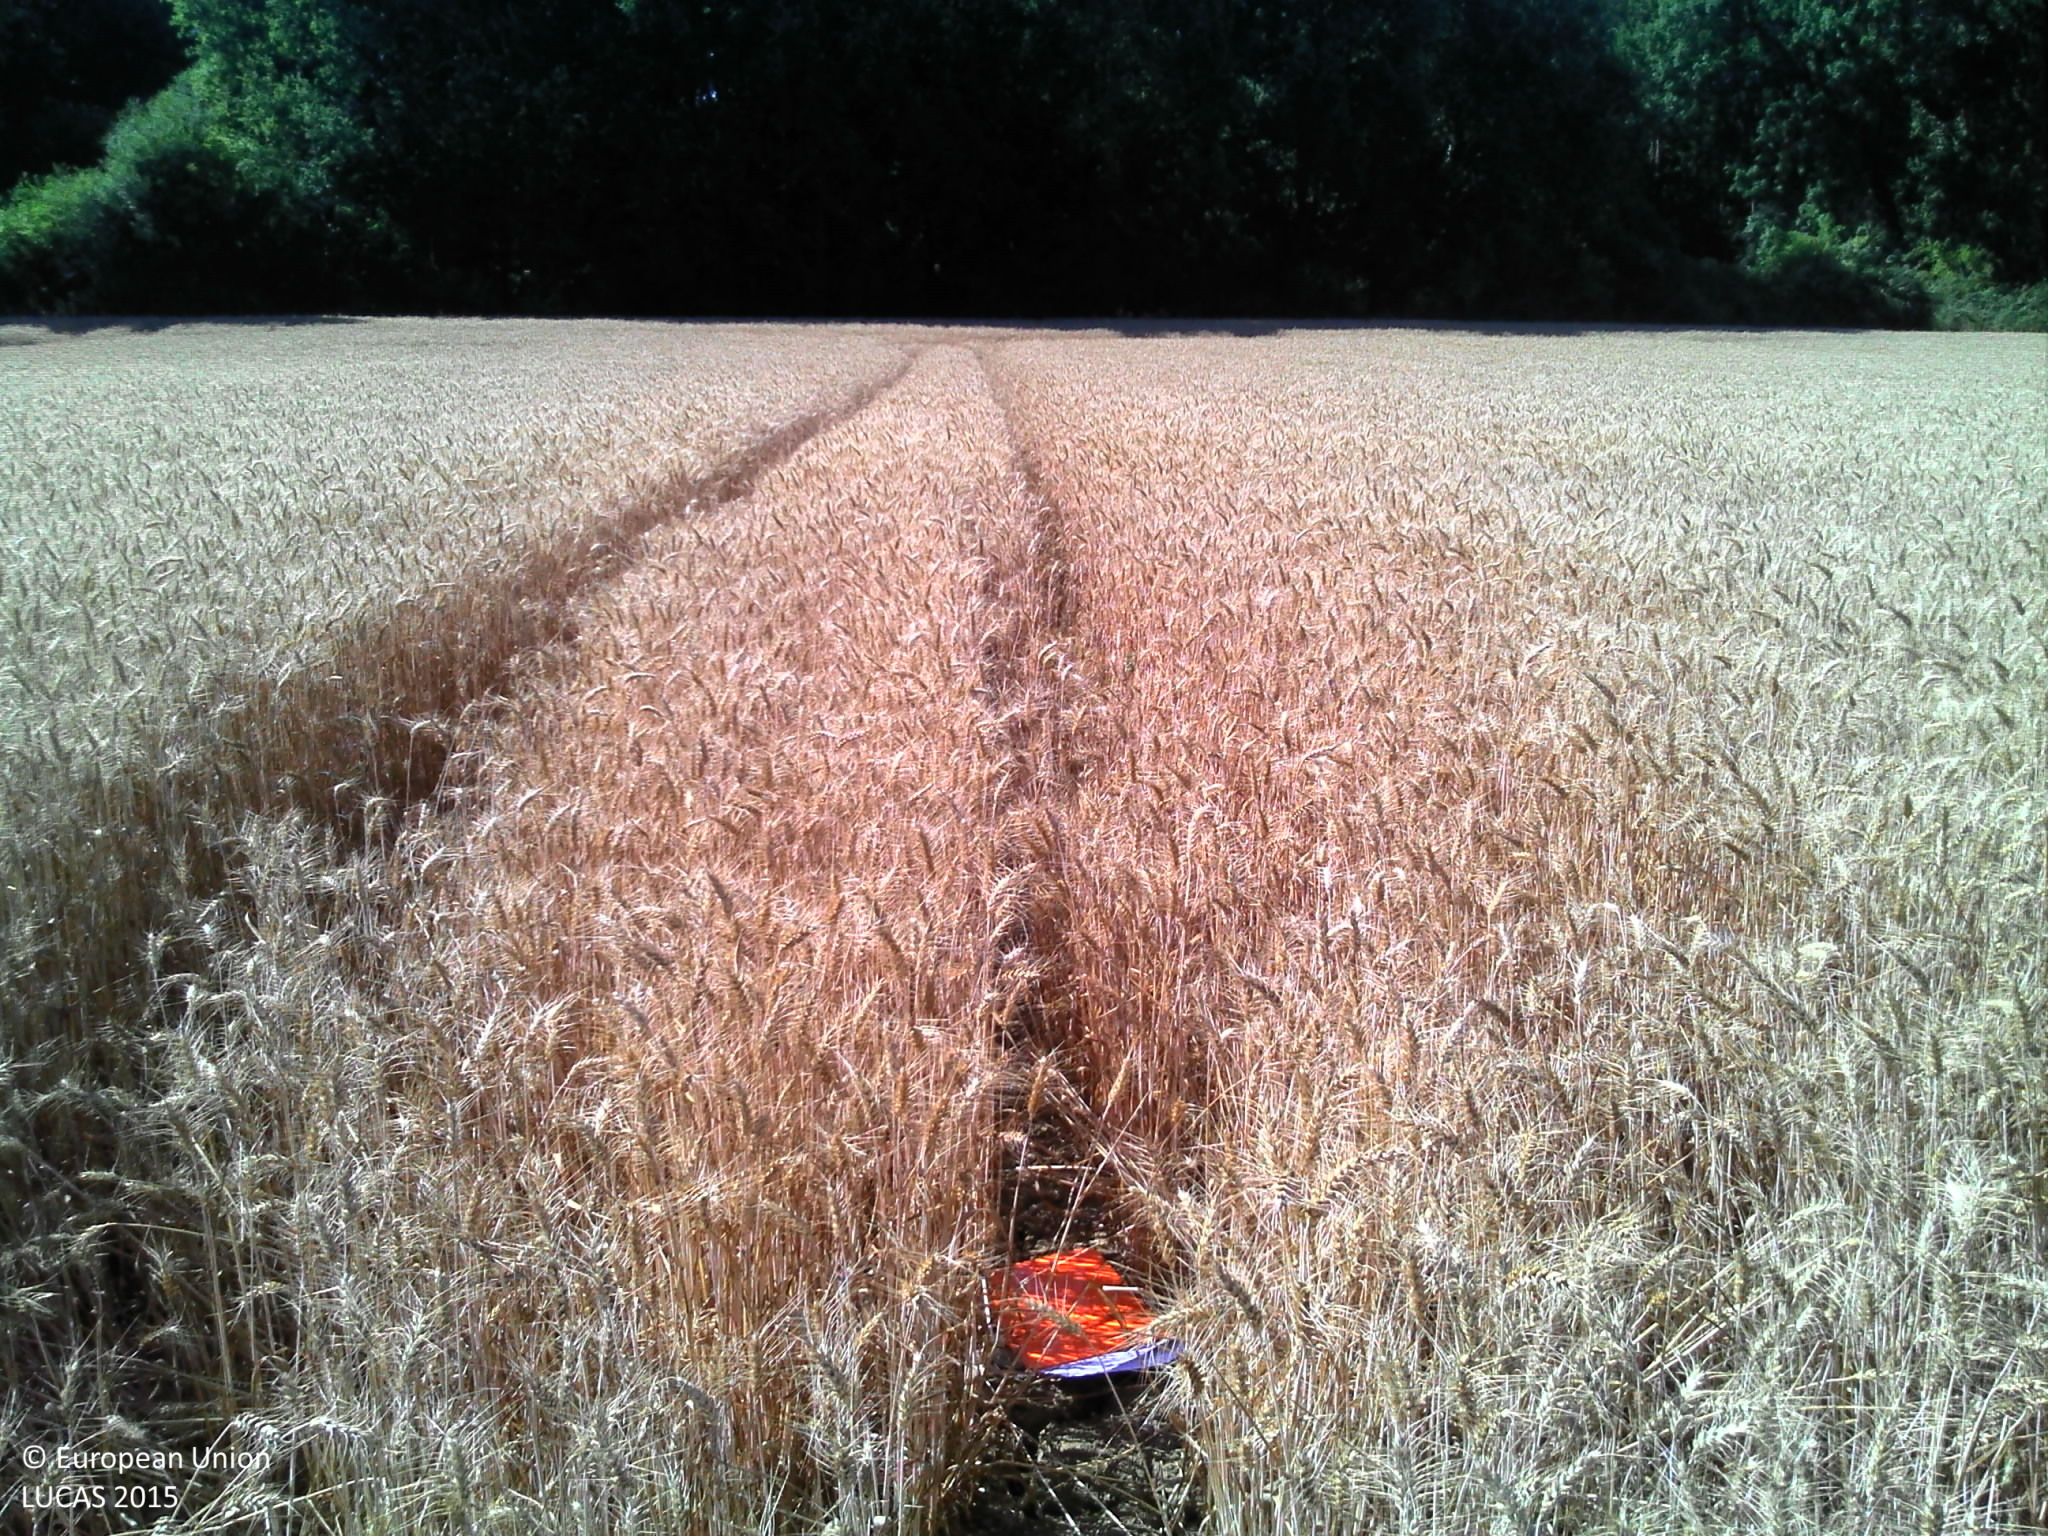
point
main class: Cropland
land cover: Common wheat
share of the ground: > 75 %
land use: Agriculture (excluding fallow land and kitchen gardens)
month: July
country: FR
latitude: 47.9126
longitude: 2.4845
